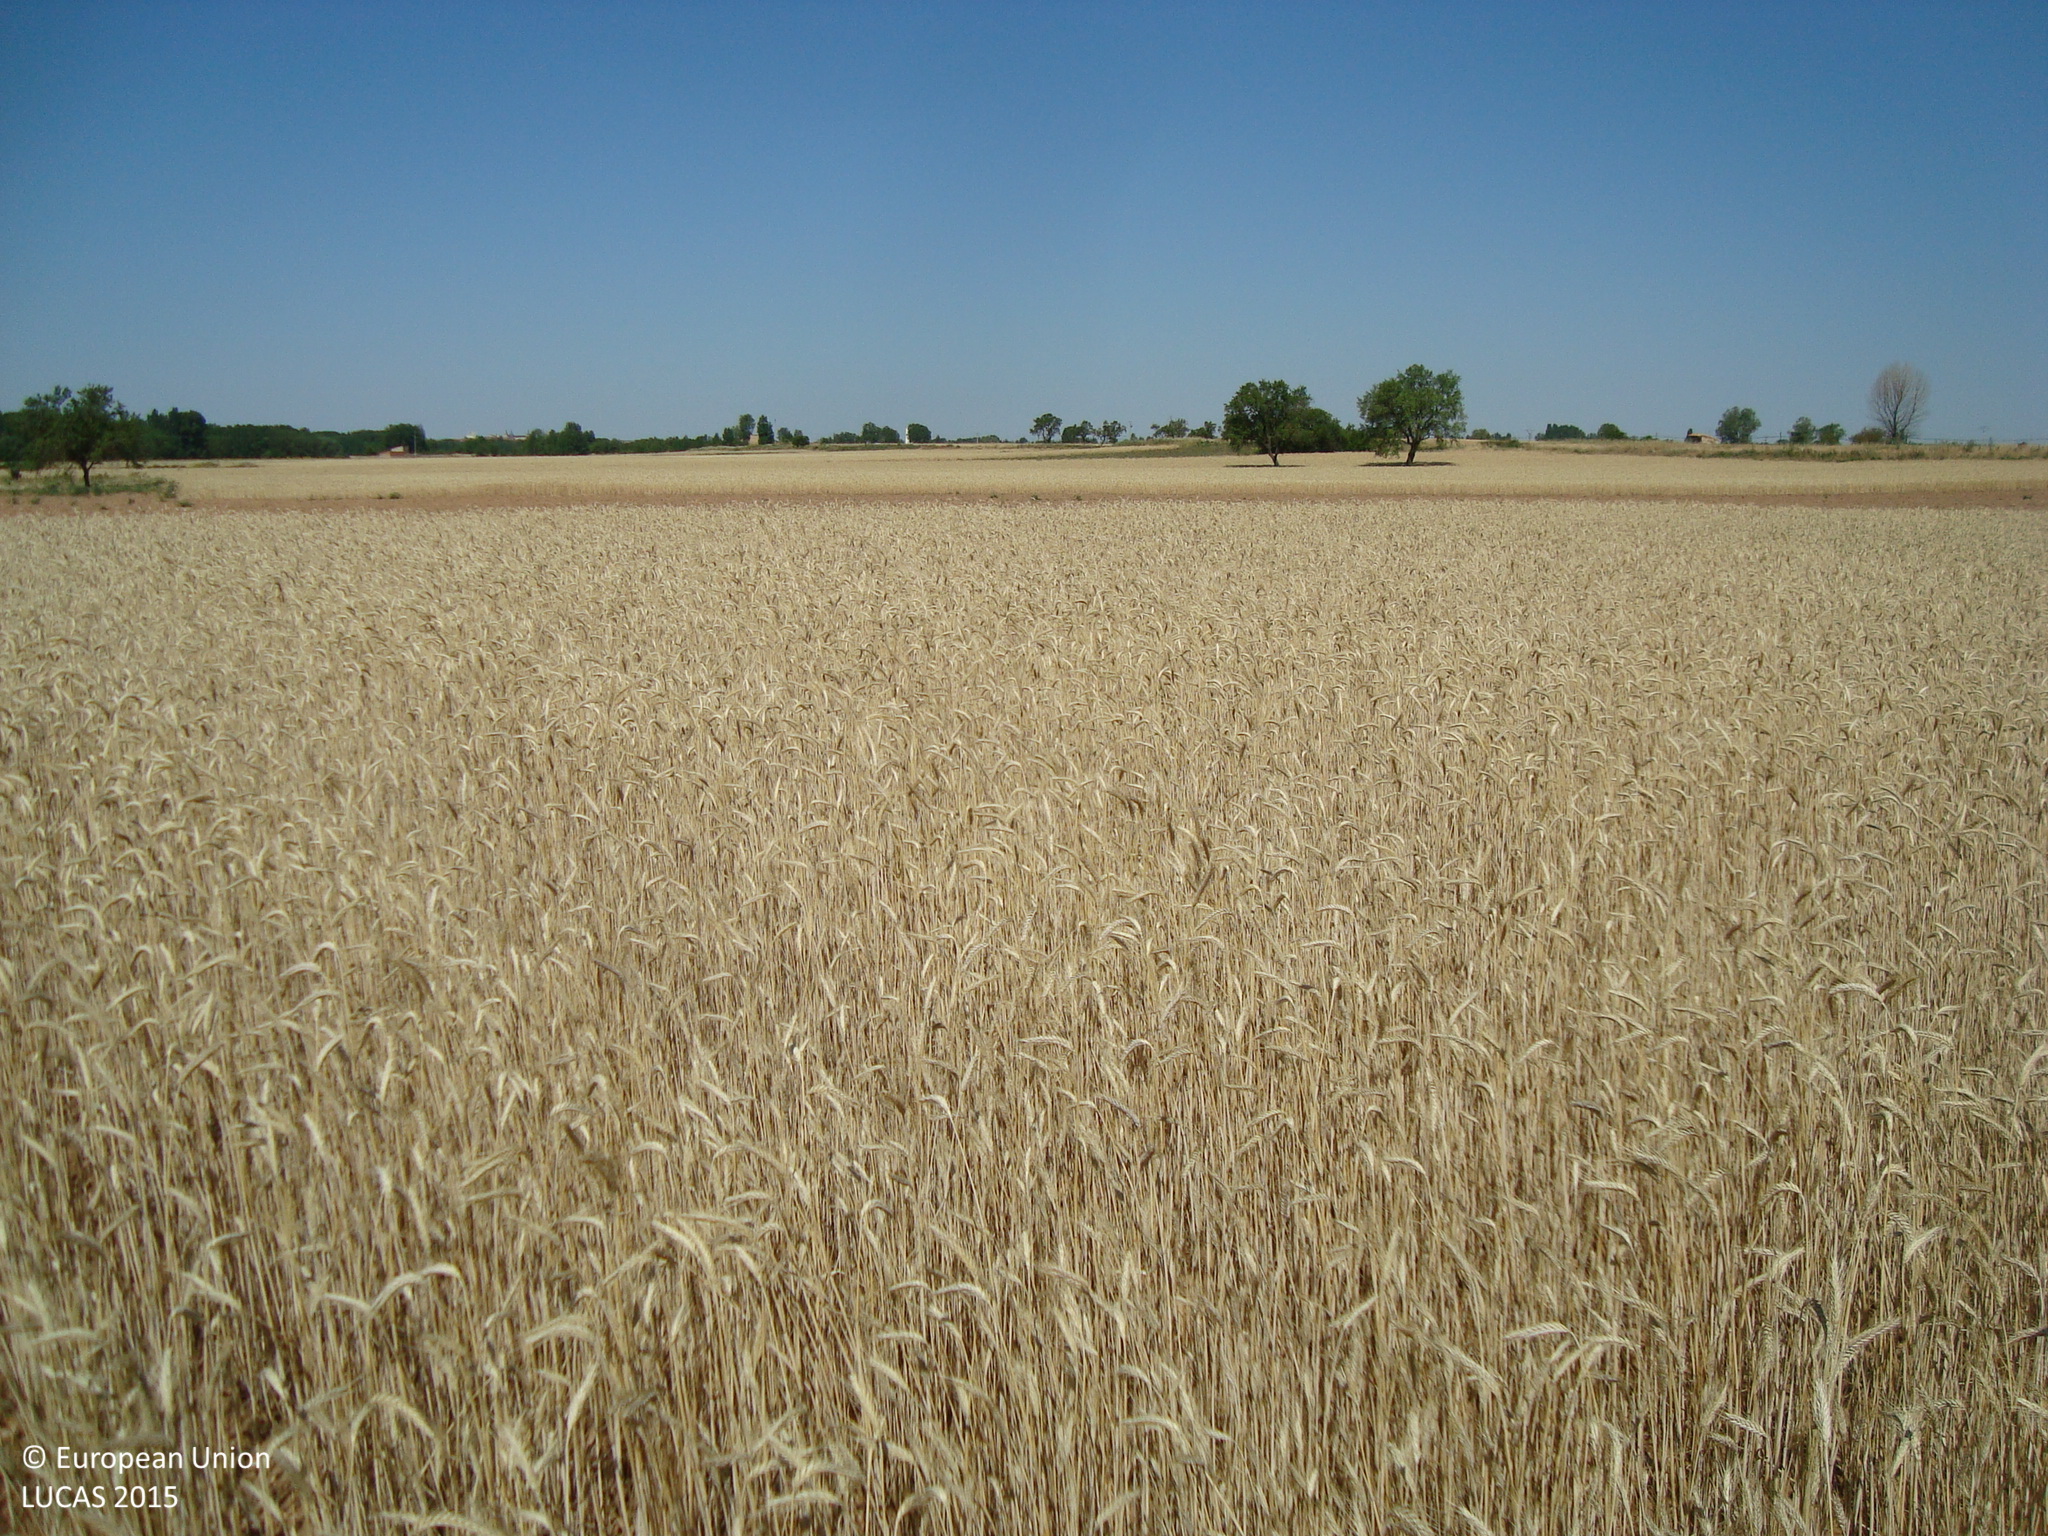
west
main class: Cropland
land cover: Barley
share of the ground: > 75 %
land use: Agriculture (excluding fallow land and kitchen gardens)
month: June
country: ES
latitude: 42.0300
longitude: -3.6936
